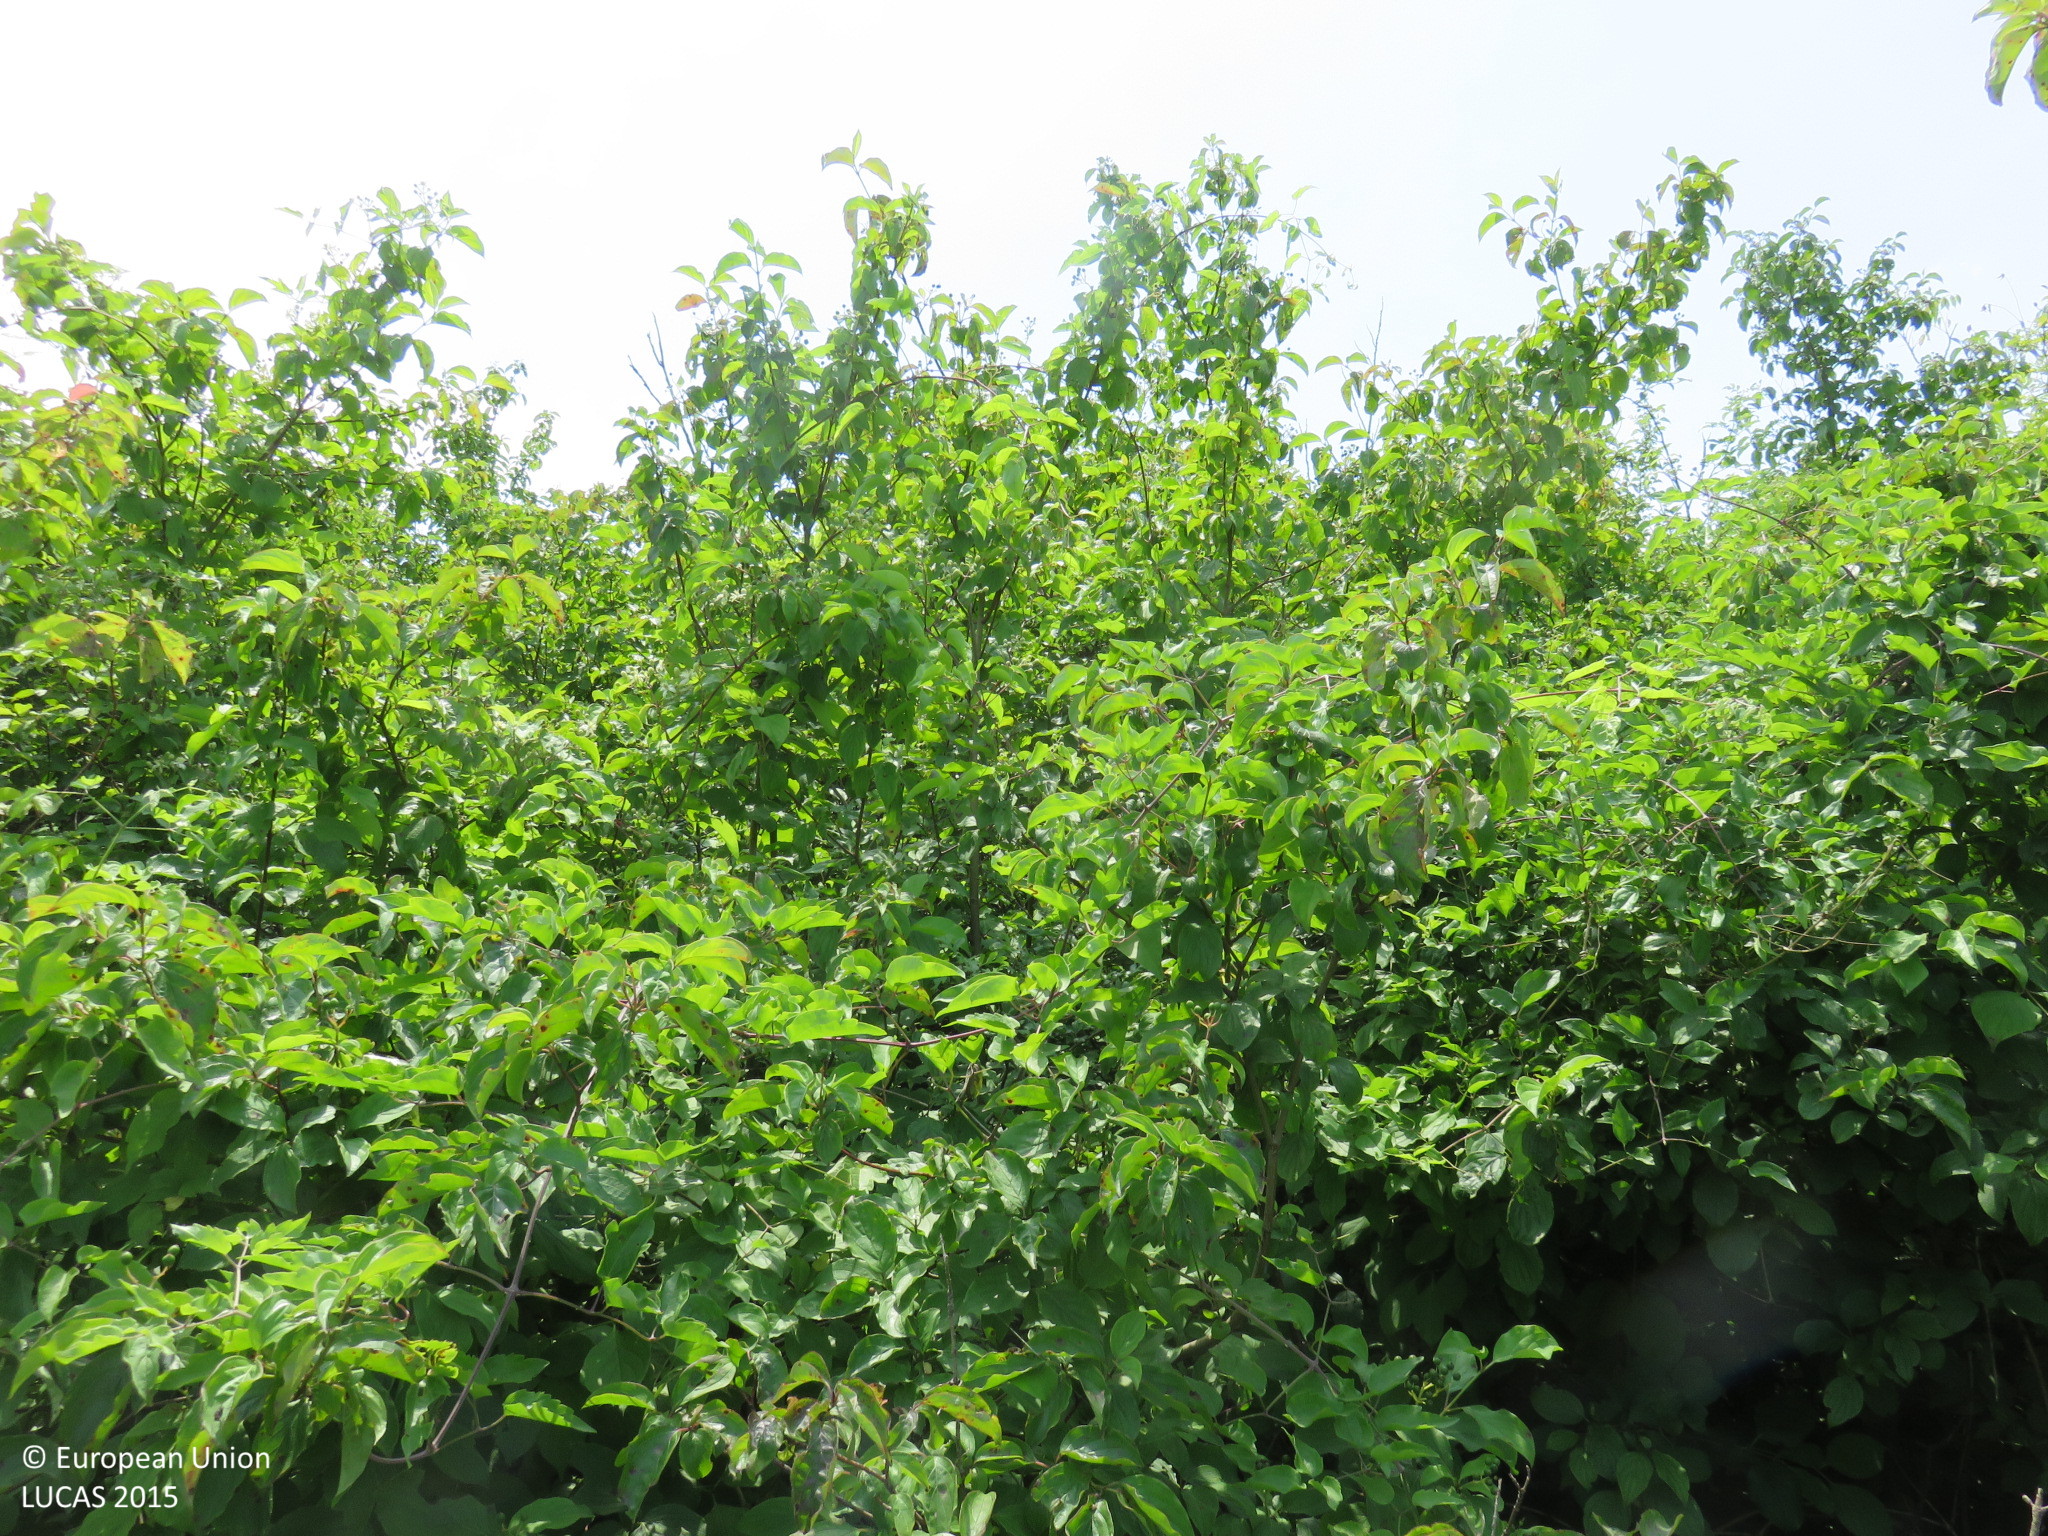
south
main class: Shrubland
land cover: Shrubland with sparse tree cover
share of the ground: > 75 %
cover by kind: shrubs 95 %, broadleaved forest trees 5 %
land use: Fallow land
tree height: < 5 m
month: June
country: BG
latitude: 43.4282
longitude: 24.5517
